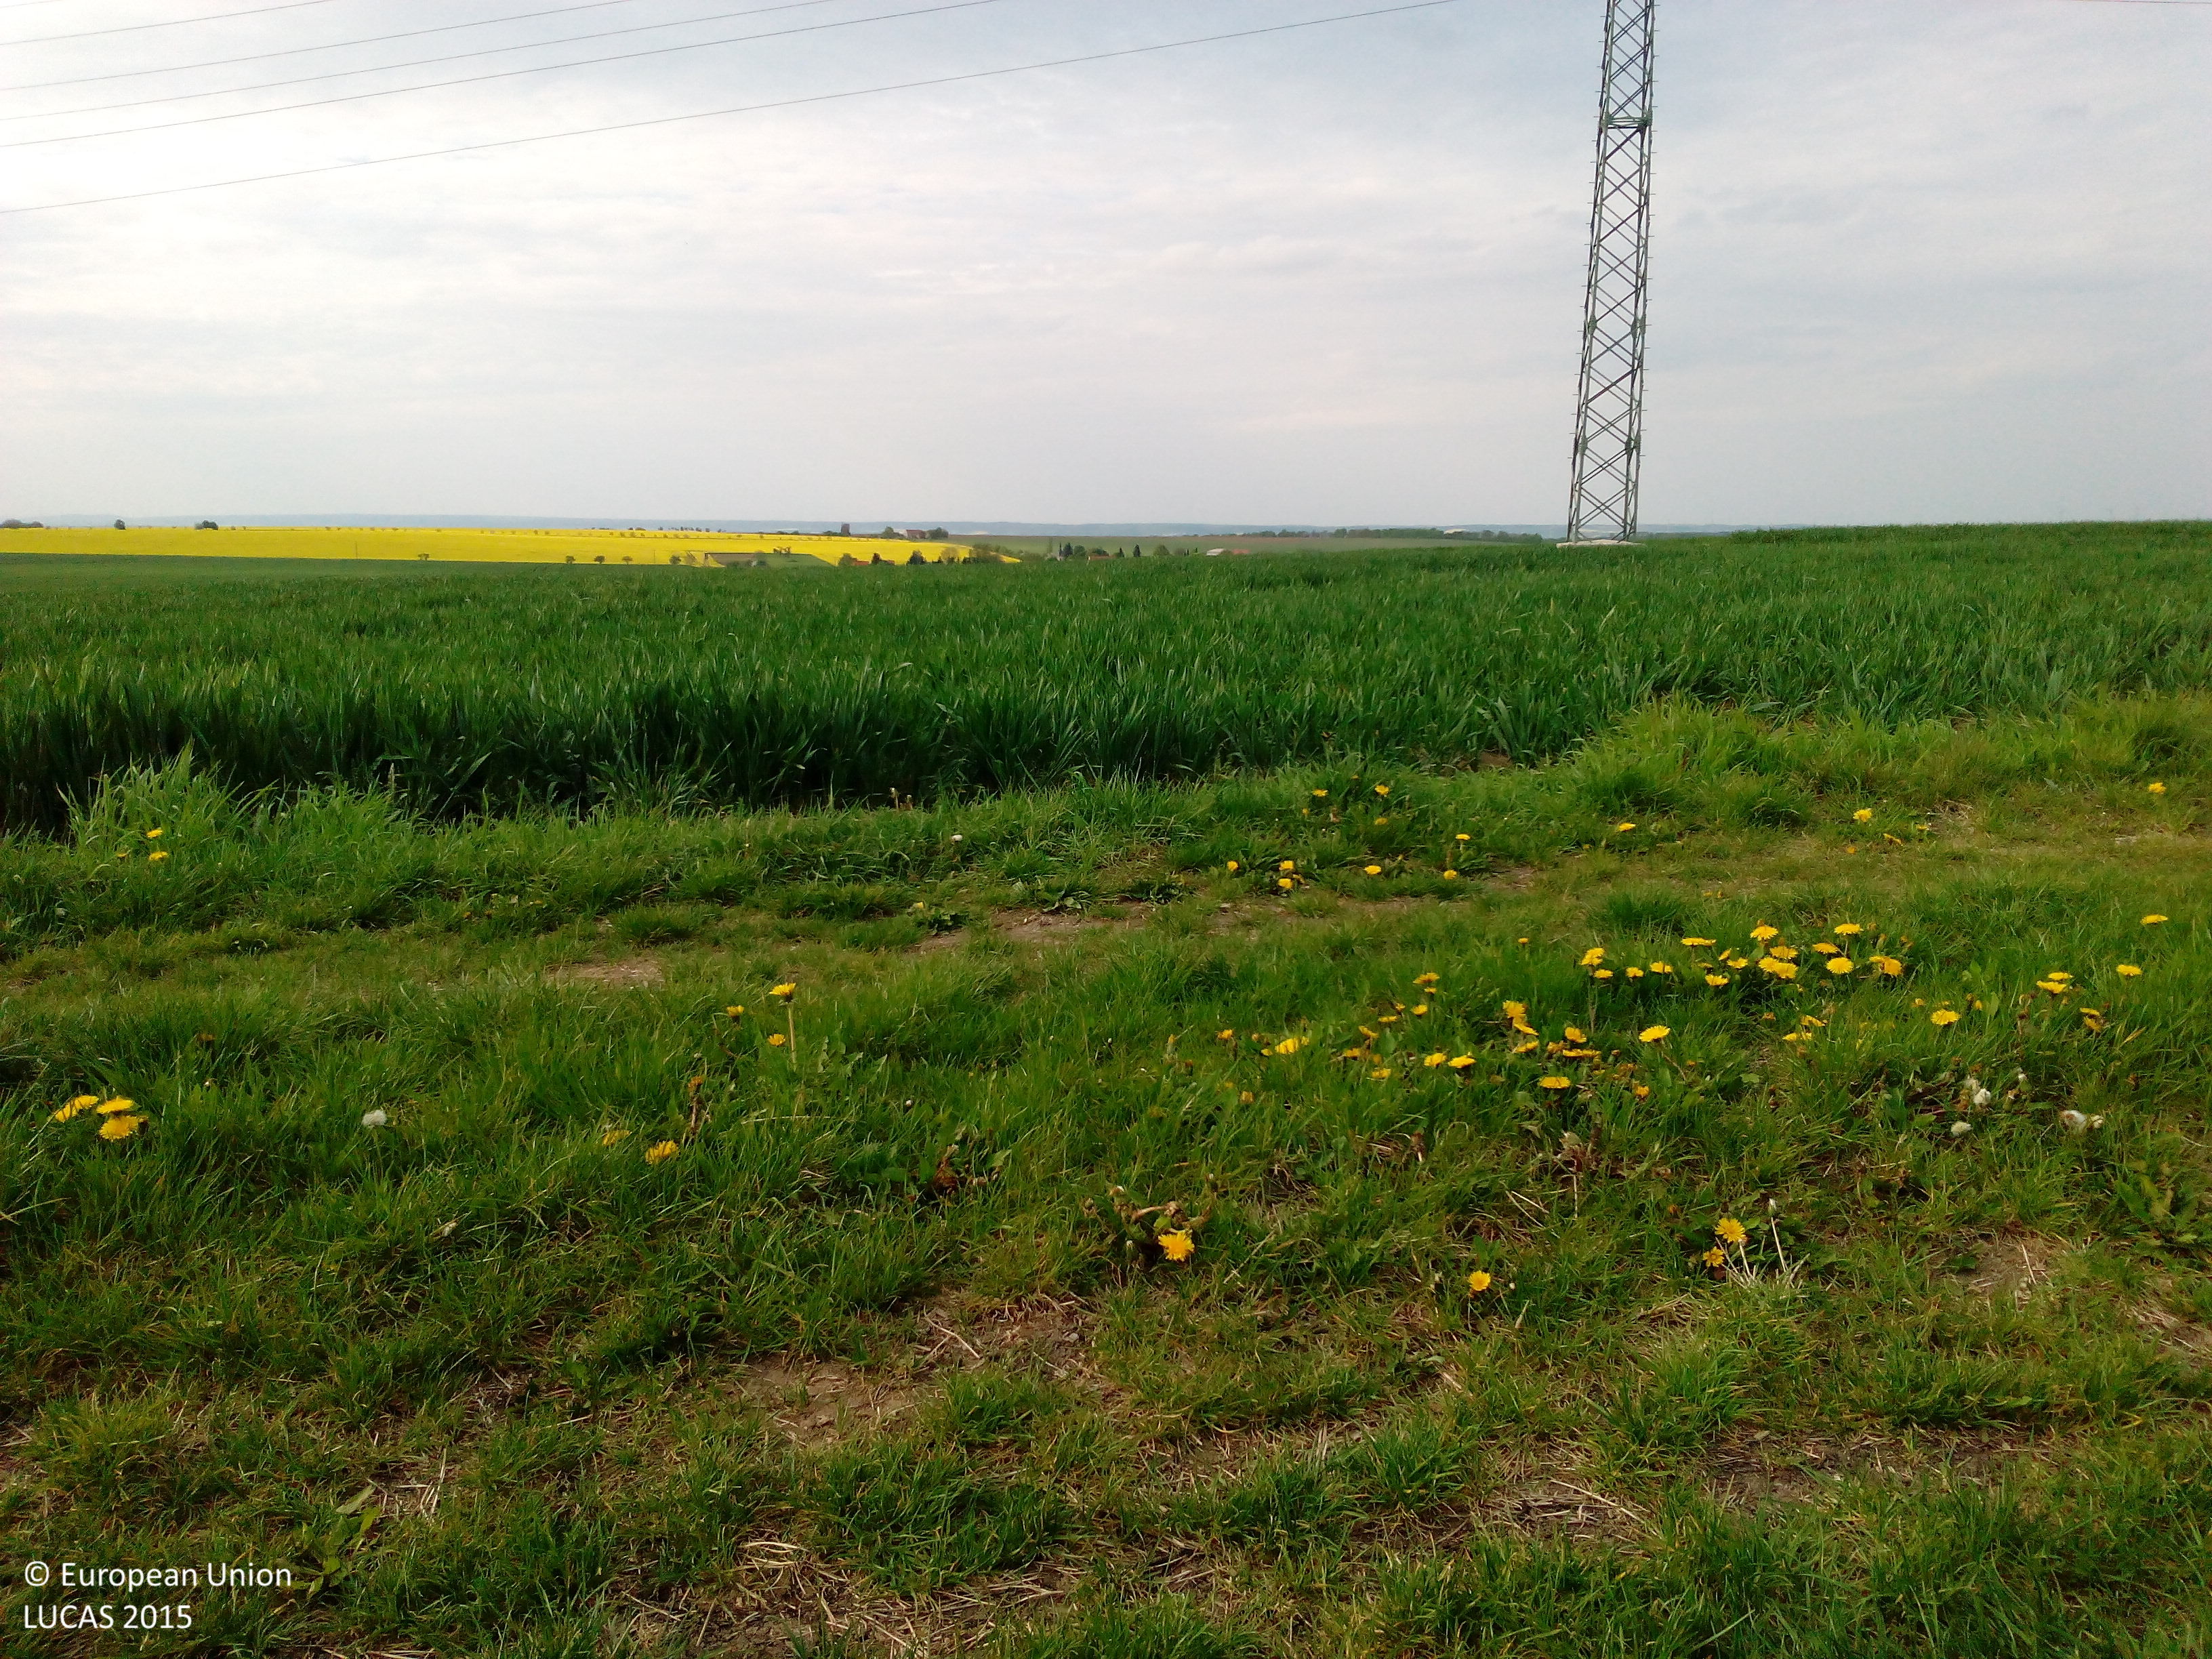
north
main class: Cropland
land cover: Common wheat
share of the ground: > 75 %
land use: Agriculture (excluding fallow land and kitchen gardens)
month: May
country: DE
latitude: 50.9650
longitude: 11.5517
